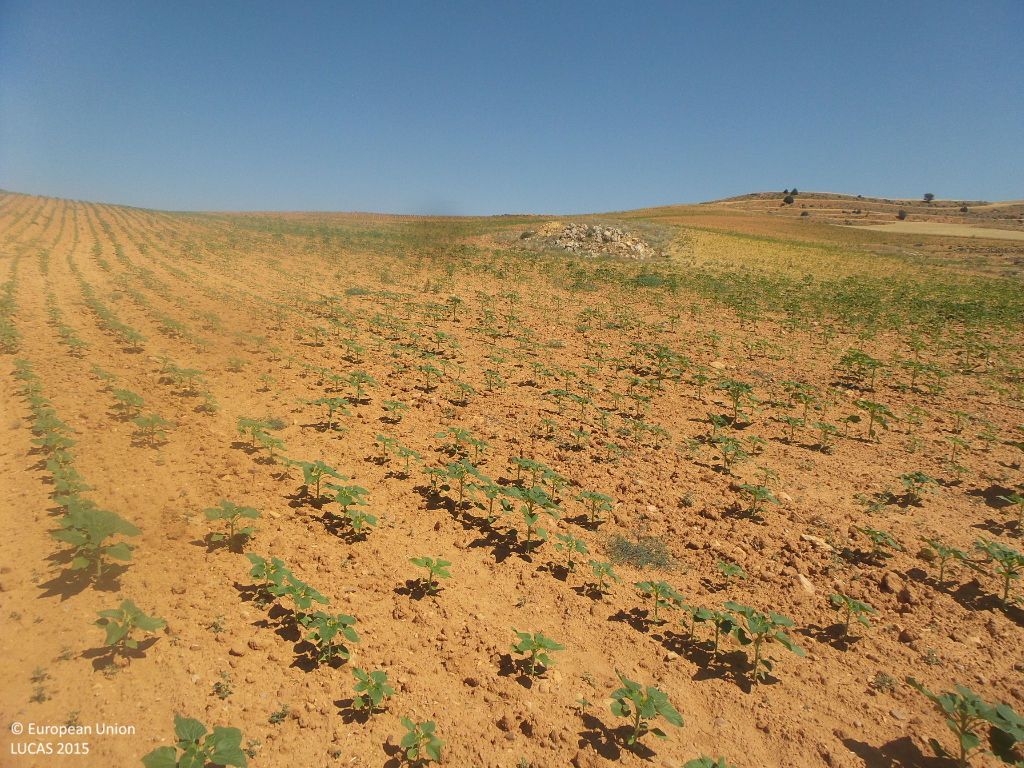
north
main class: Cropland
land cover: Sunflower
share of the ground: < 10 %
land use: Agriculture (excluding fallow land and kitchen gardens)
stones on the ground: < 10 %
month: July
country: ES
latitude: 41.1794
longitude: -1.9352
